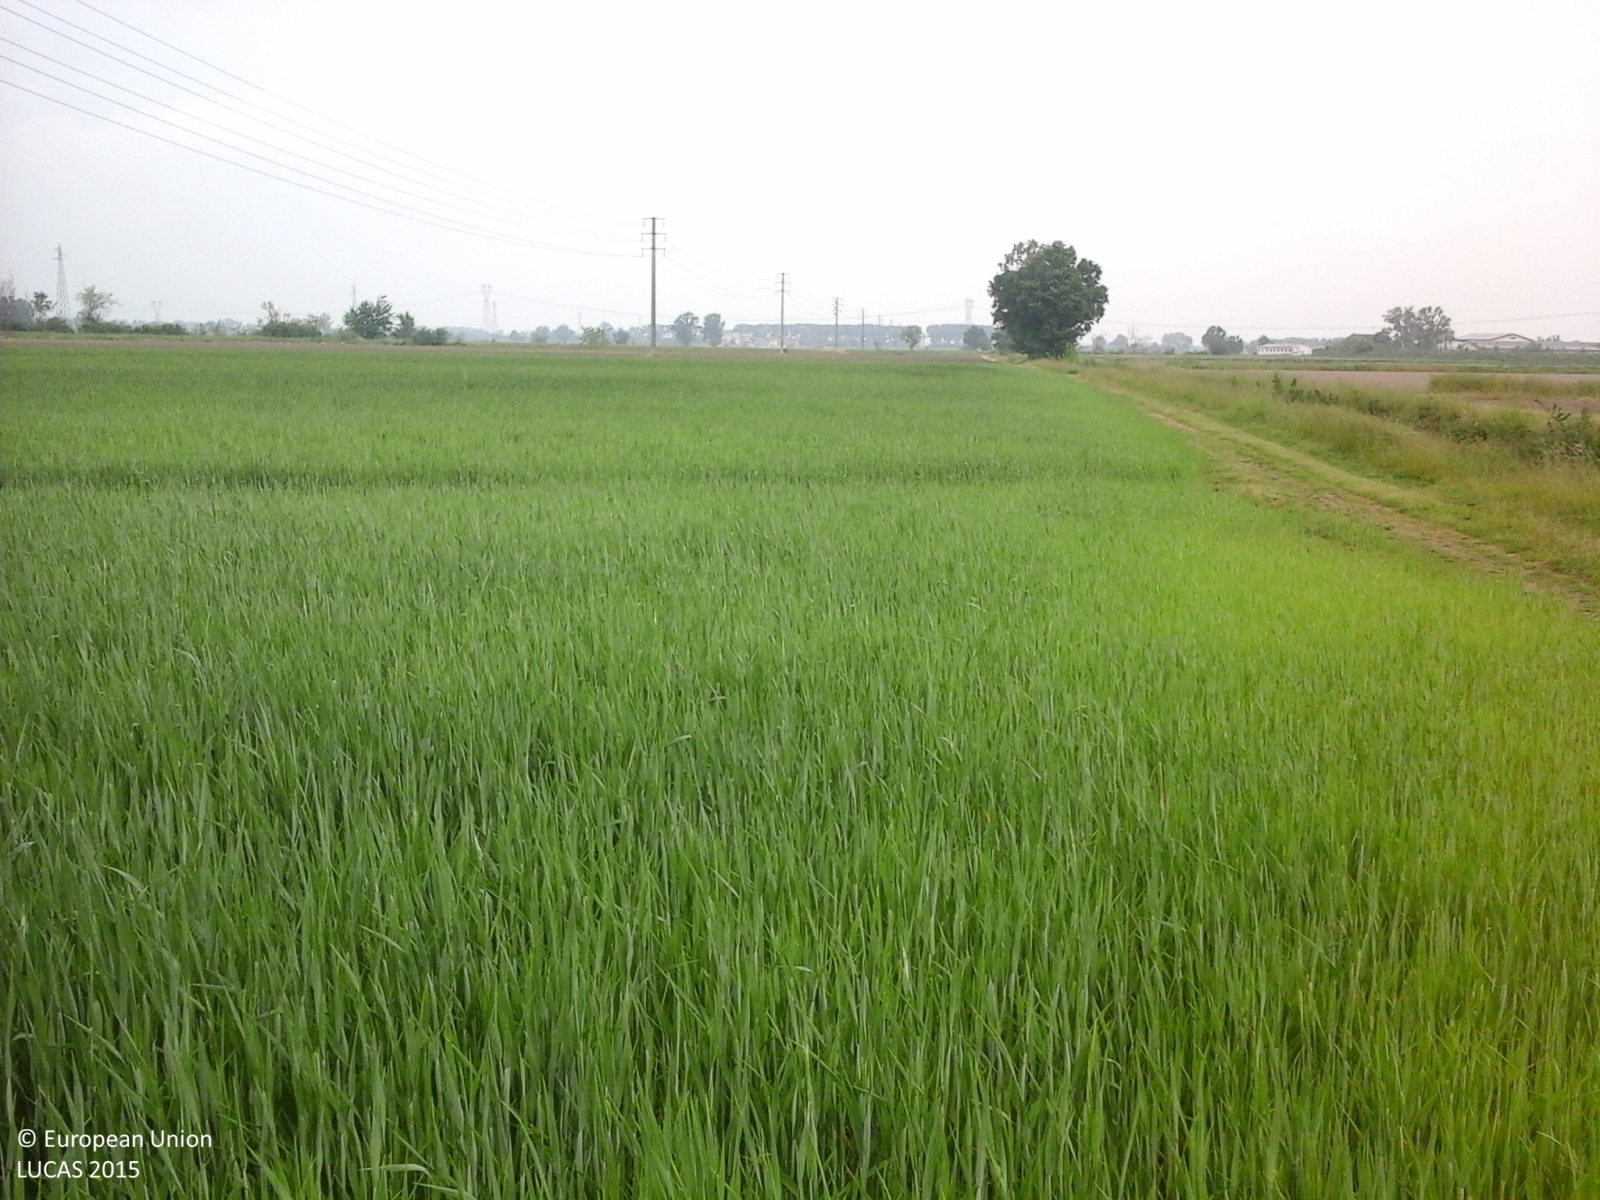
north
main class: Cropland
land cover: Common wheat
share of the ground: > 75 %
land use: Agriculture (excluding fallow land and kitchen gardens)
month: May
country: IT
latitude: 44.9982
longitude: 10.5697
